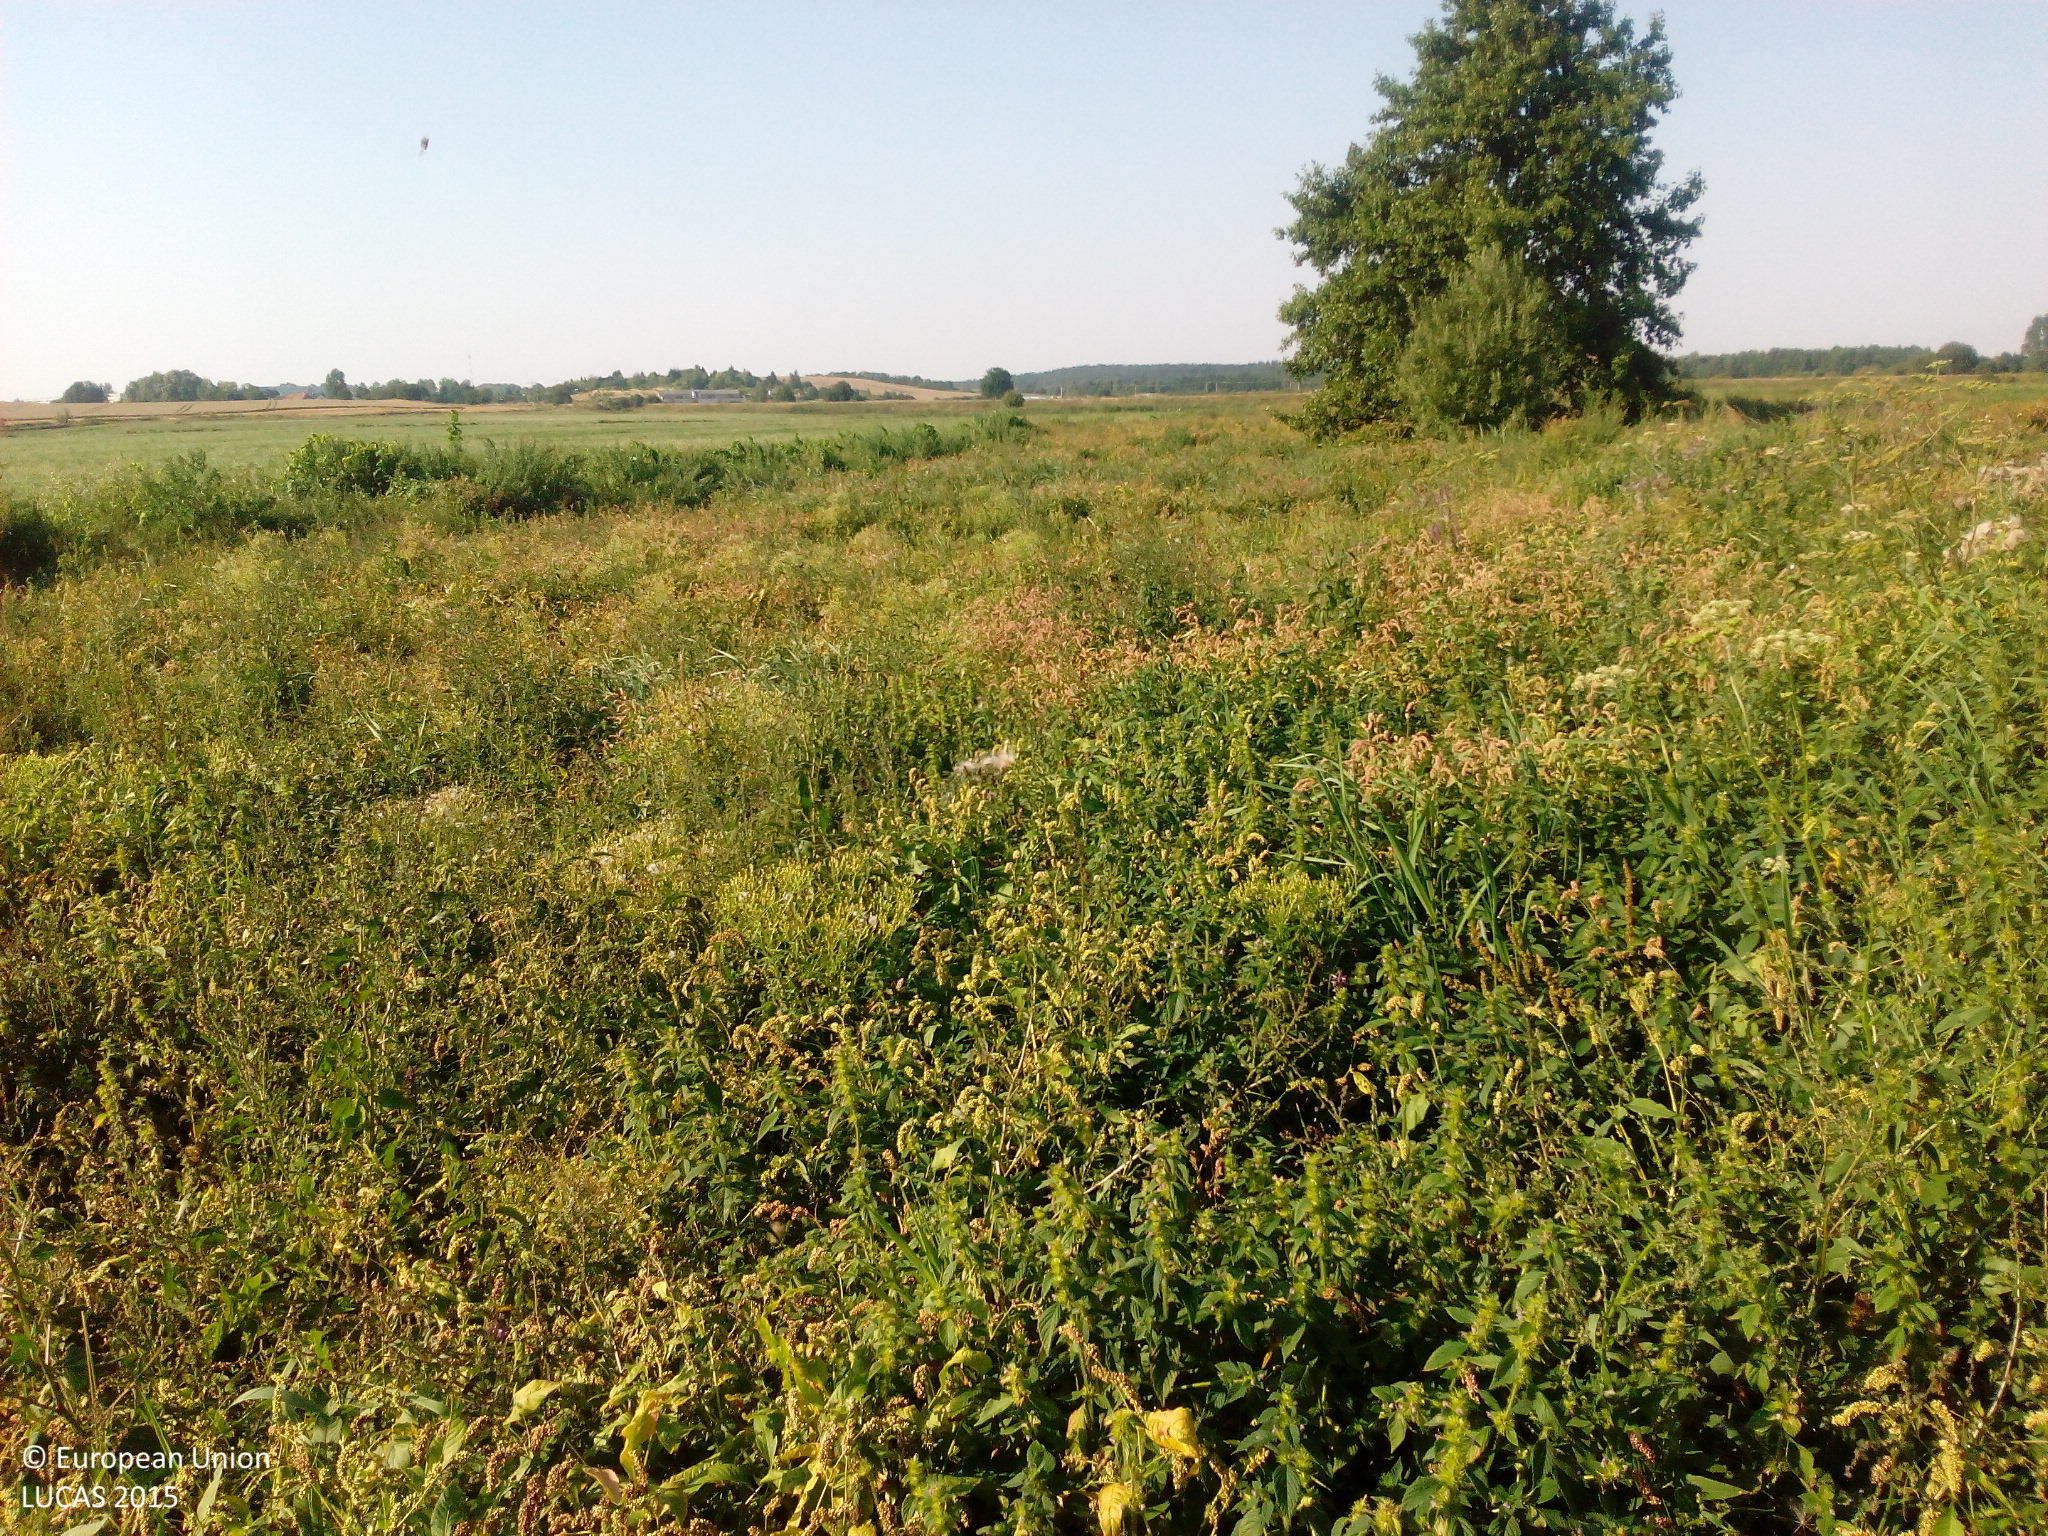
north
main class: Grassland
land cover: Spontaneously vegetated surfaces
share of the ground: > 75 %
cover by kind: herbaceous plants 100 %
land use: Semi-natural and natural areas not in use
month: August
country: DE
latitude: 53.9190
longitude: 12.3287
